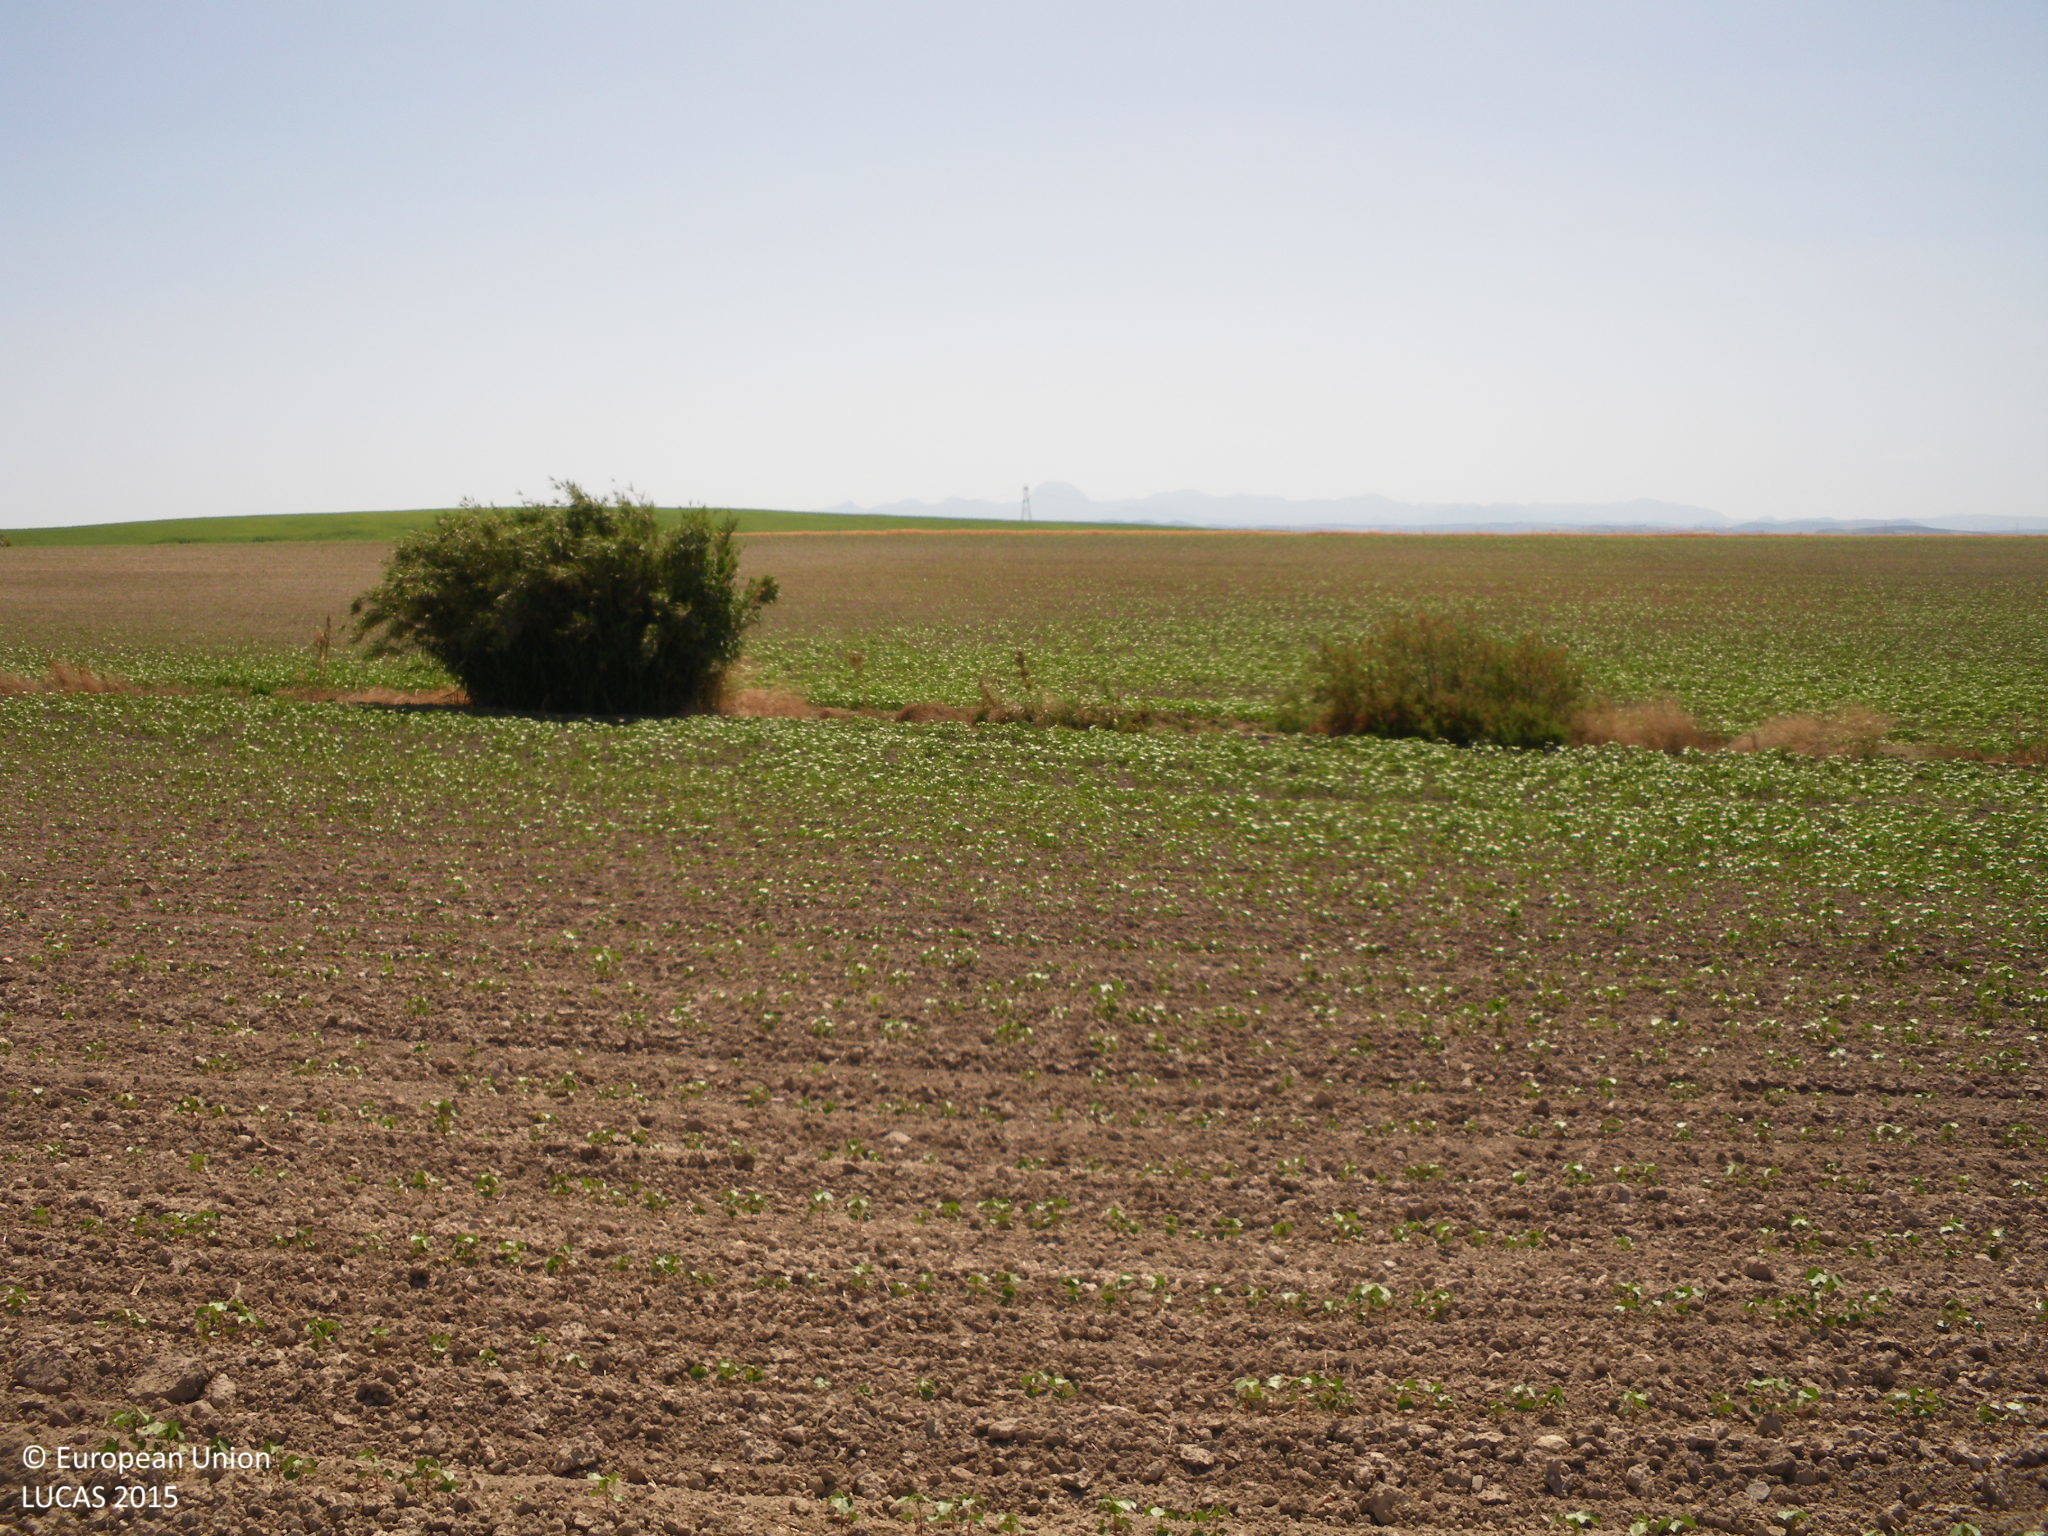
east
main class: Cropland
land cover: Cotton
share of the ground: 10 - 25 %
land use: Agriculture (excluding fallow land and kitchen gardens)
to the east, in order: Cotton; Managed hedges; Grass margins; Cotton; Fences; Durum wheat
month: June
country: ES
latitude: 36.7960
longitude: -5.9594
